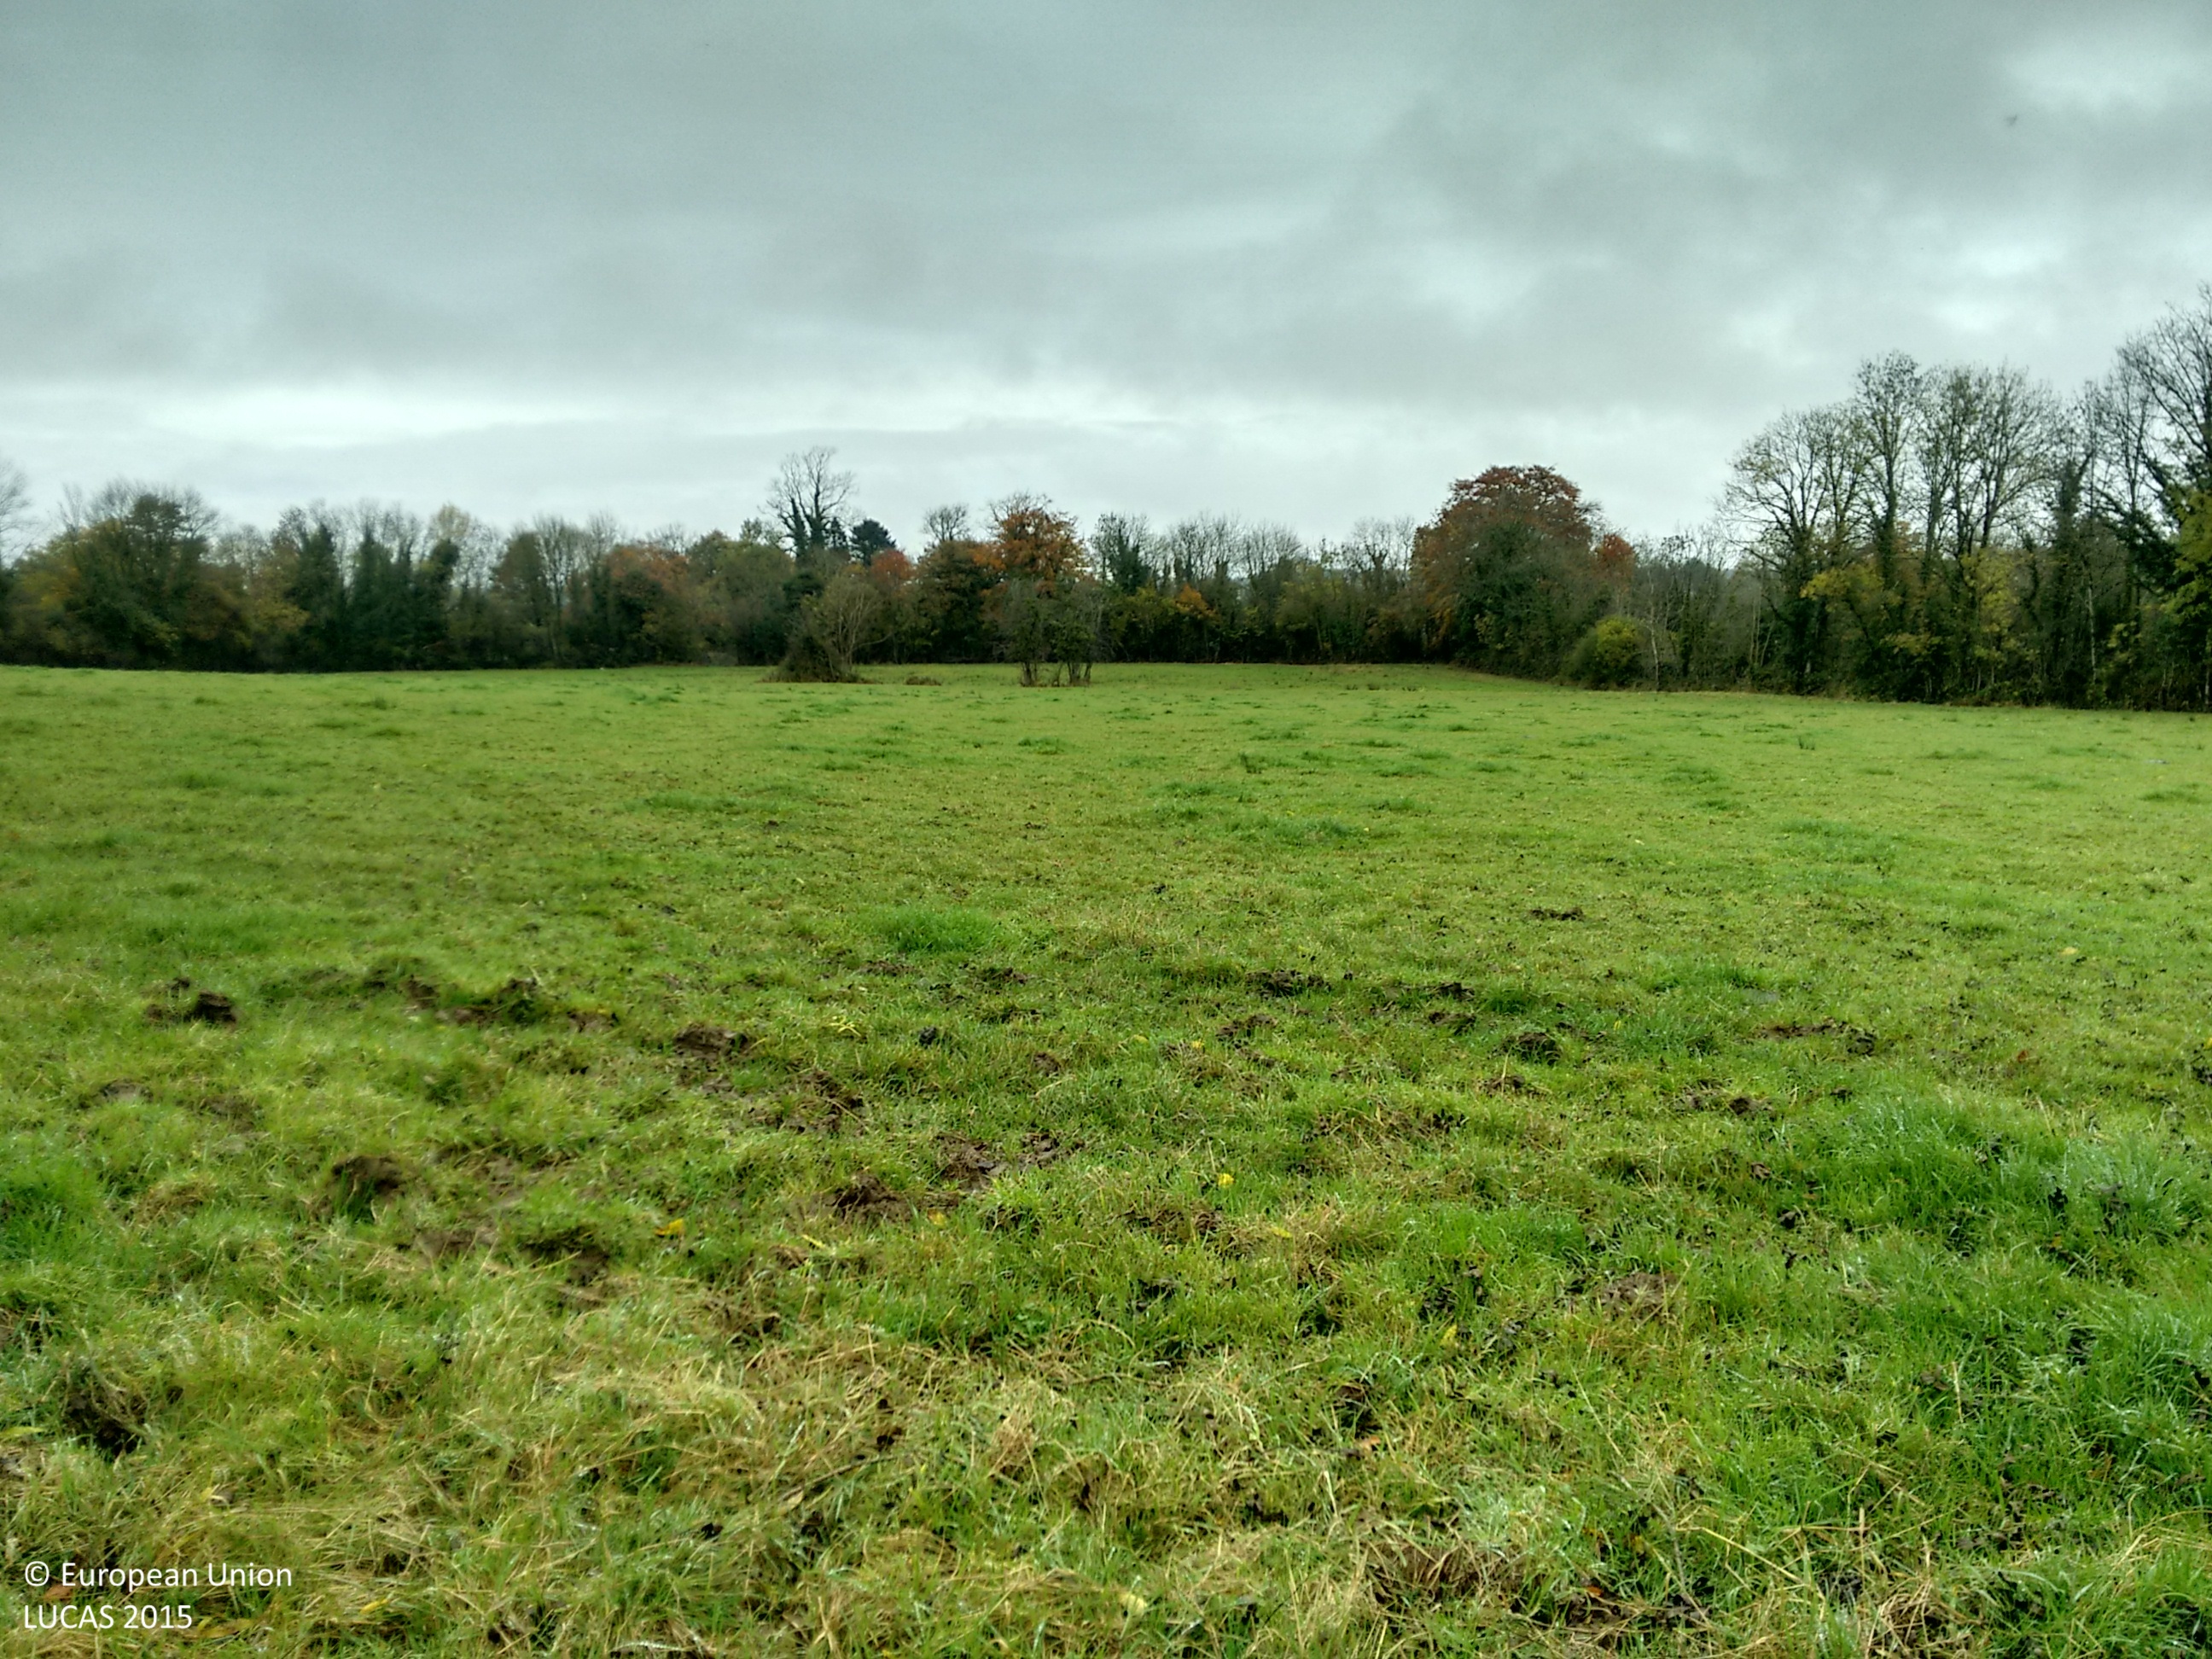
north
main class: Grassland
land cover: Grassland without tree/shrub cover
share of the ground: > 75 %
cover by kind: herbaceous plants 100 %
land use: Agriculture (excluding fallow land and kitchen gardens)
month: October
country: IE
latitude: 53.8487
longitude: -8.0995
